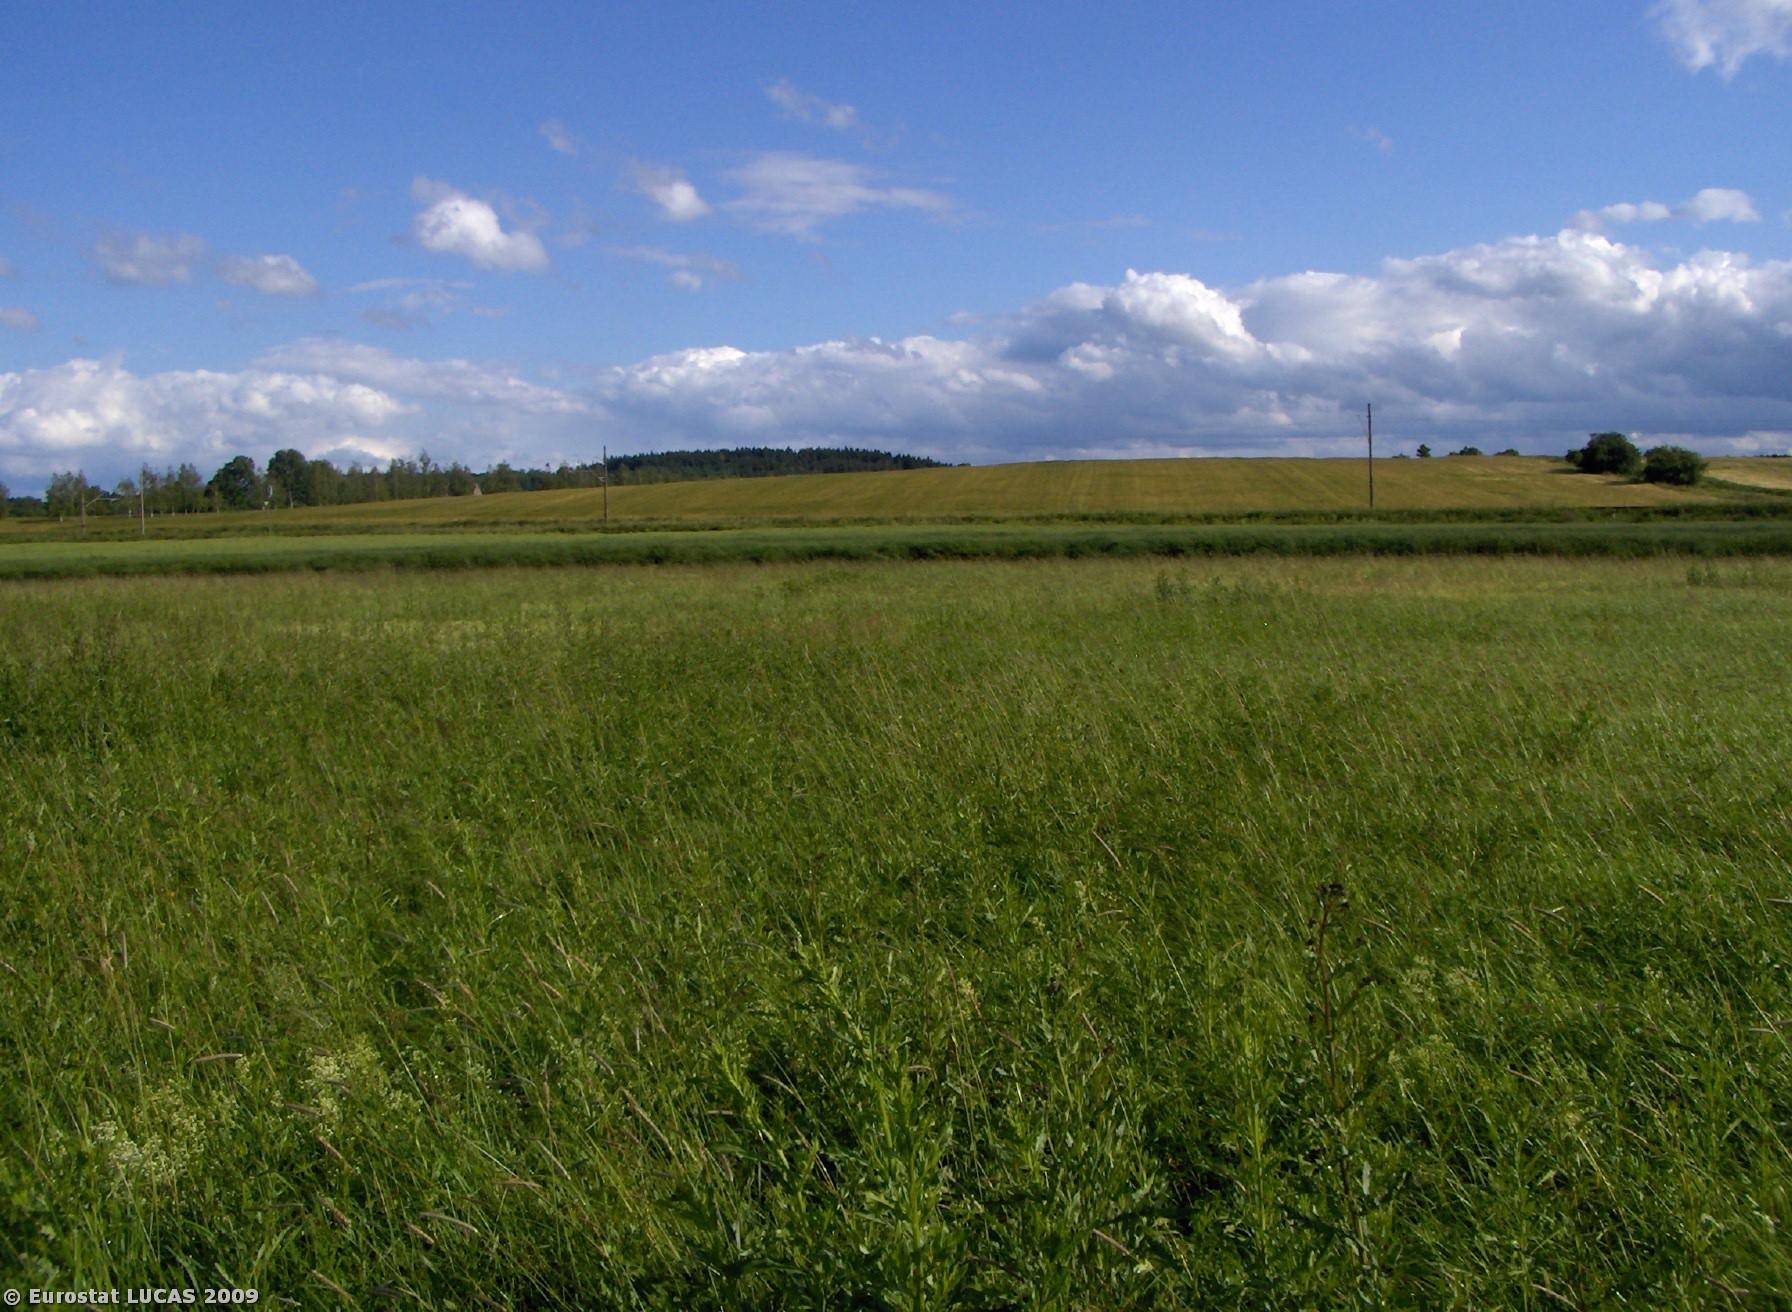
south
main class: Grassland
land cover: Grassland without tree/shrub cover
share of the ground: > 75 %
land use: Agriculture (excluding fallow land and kitchen gardens)
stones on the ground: < 10 %
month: June
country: CZ
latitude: 49.2259
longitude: 14.1613
